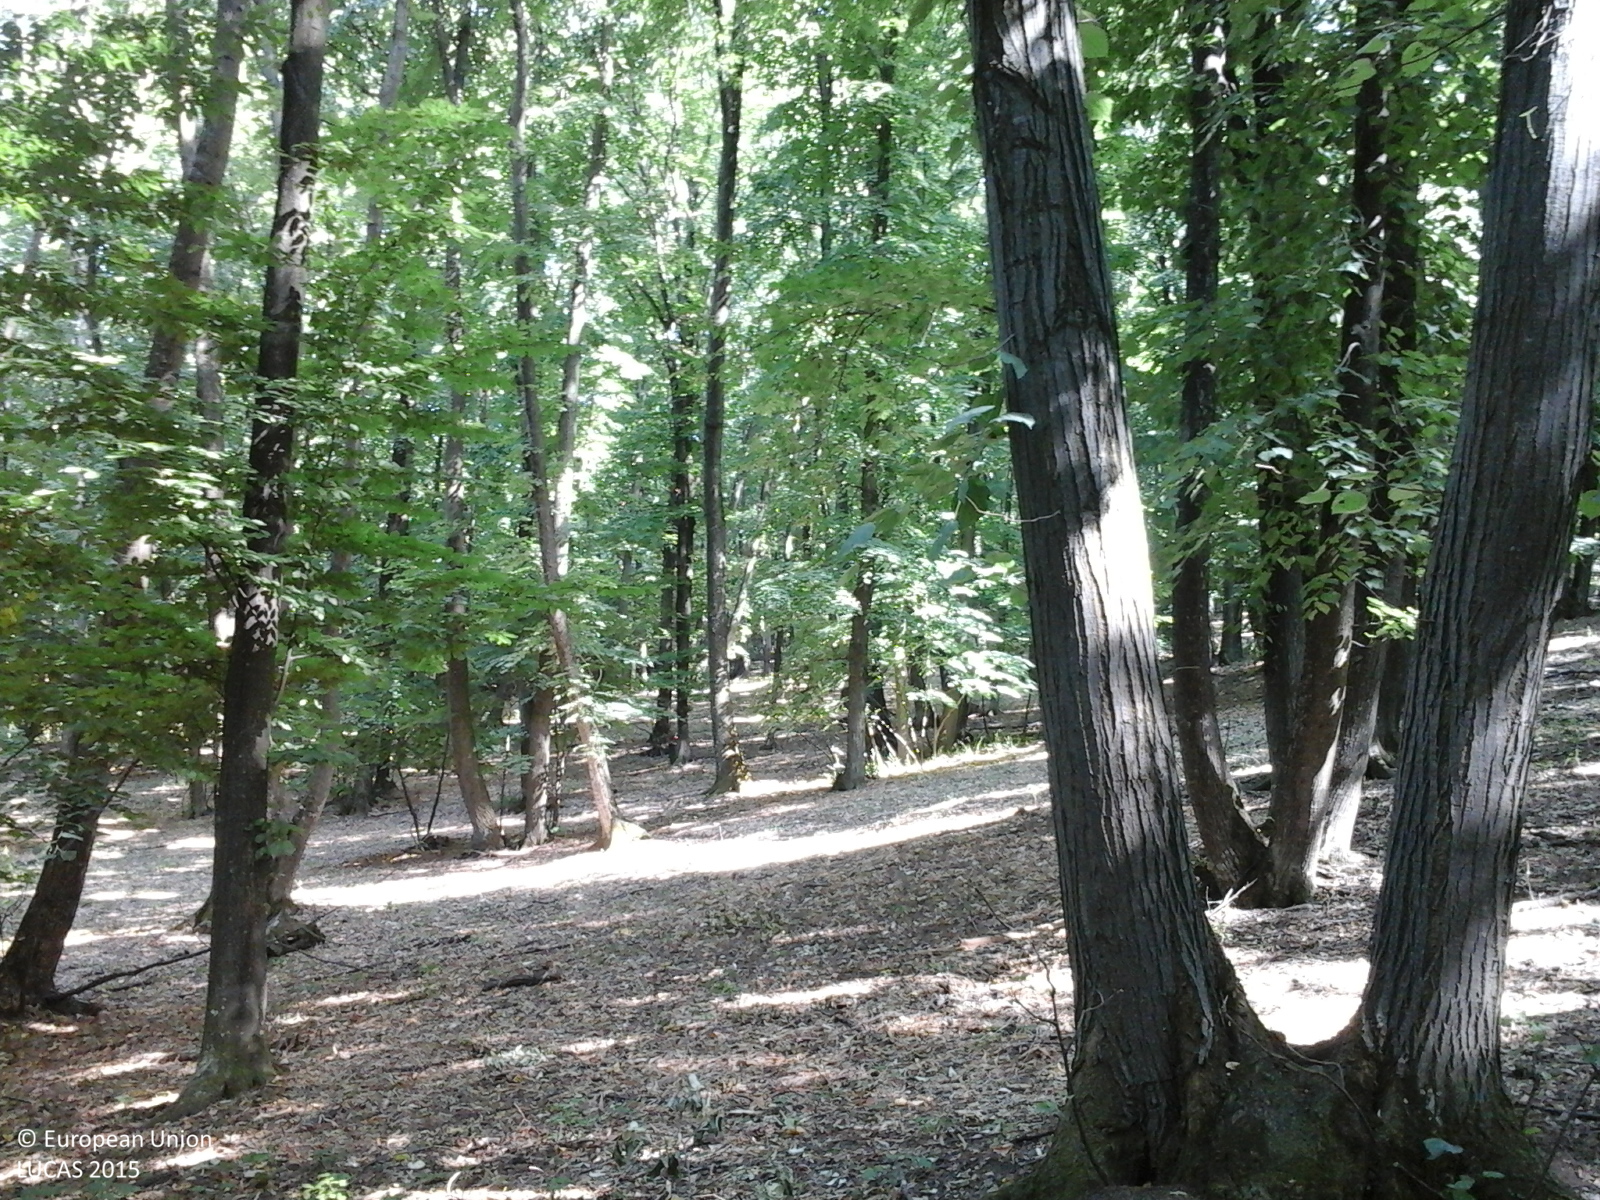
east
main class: Woodland
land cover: Broadleaved woodland
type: beech forest
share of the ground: > 75 %
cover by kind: broadleaved forest trees 100 %
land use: Forestry
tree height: > 5 m
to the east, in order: Broadleaved woodland; Rivers and streams; Broadleaved woodland
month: June
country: RO
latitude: 46.9968
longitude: 27.9203
